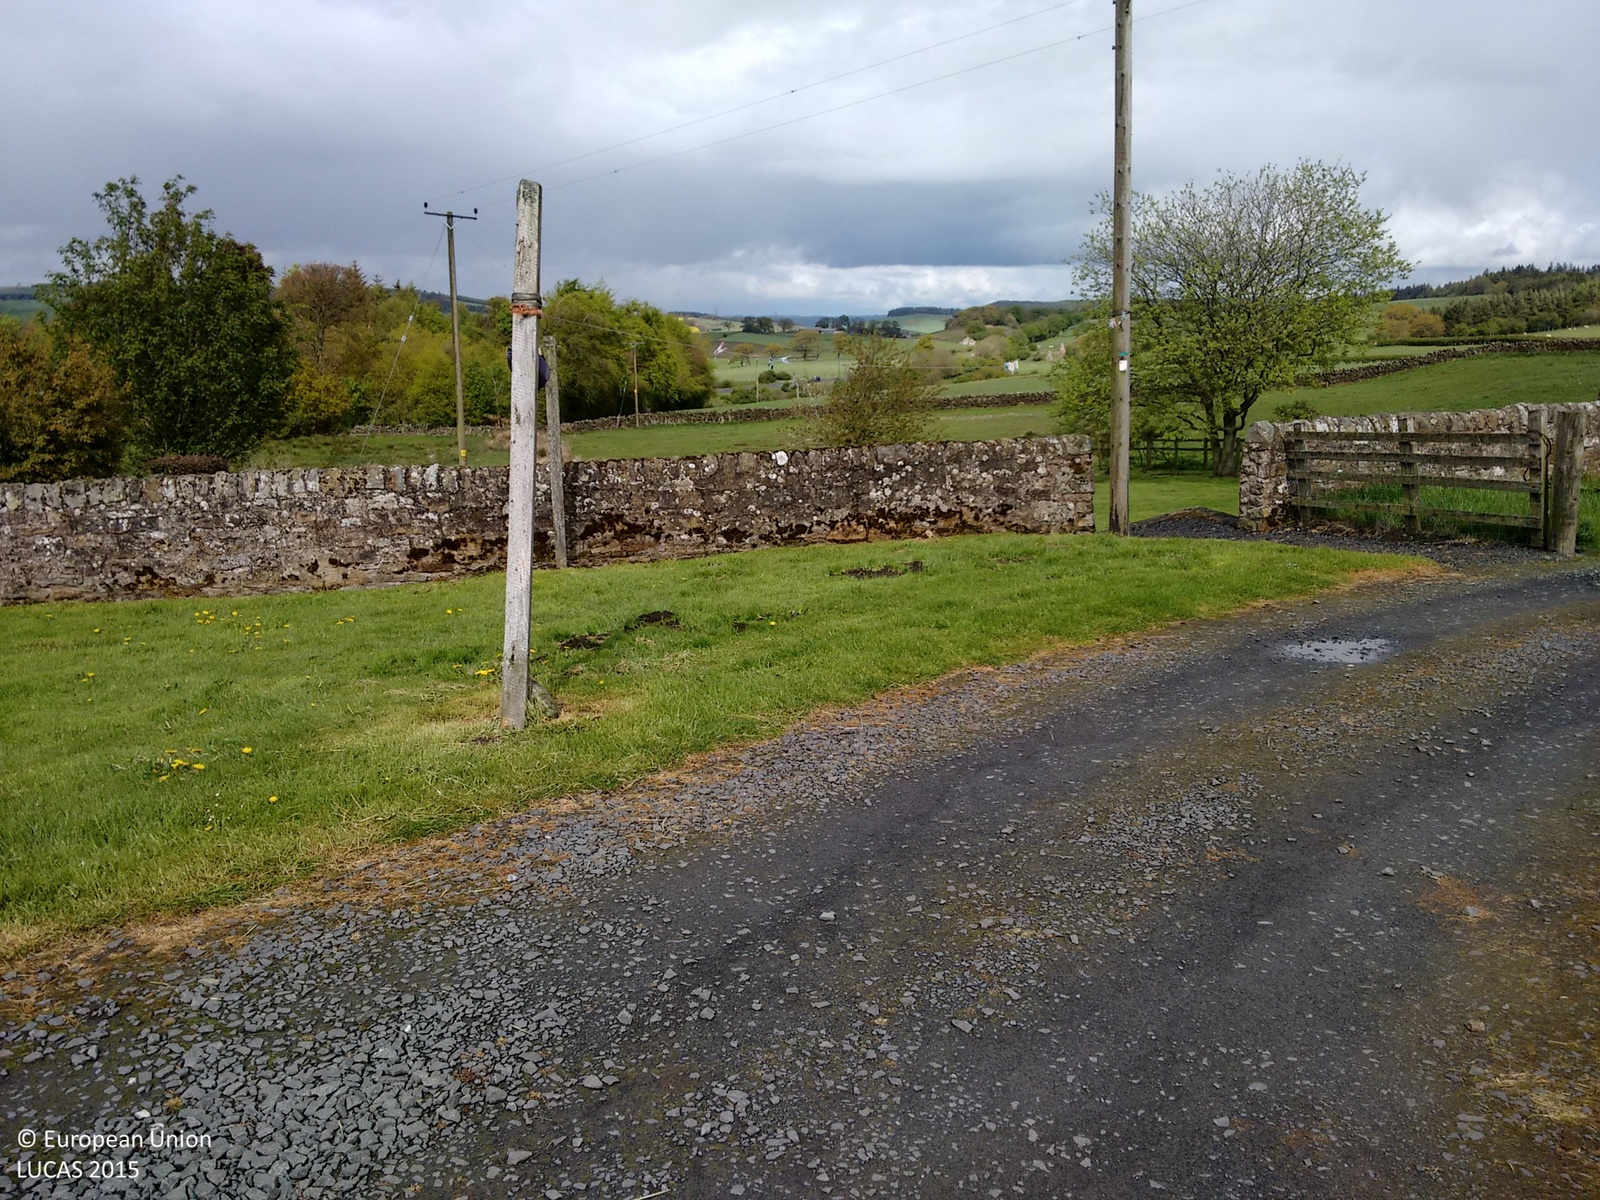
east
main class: Woodland
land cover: Pine dominated mixed woodland
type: exotic forest
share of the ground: > 75 %
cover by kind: coniferous forest trees 75 %, broadleaved forest trees 25 %
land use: Forestry
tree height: > 5 m
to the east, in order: Pine dominated mixed woodland; Spruce dominated coniferous woodland; Grassland without tree/shrub cover; Single bushes/trees; Dry stone walls; Grassland without tree/shrub cover
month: May
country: GB
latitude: 54.9841
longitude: -2.1997
